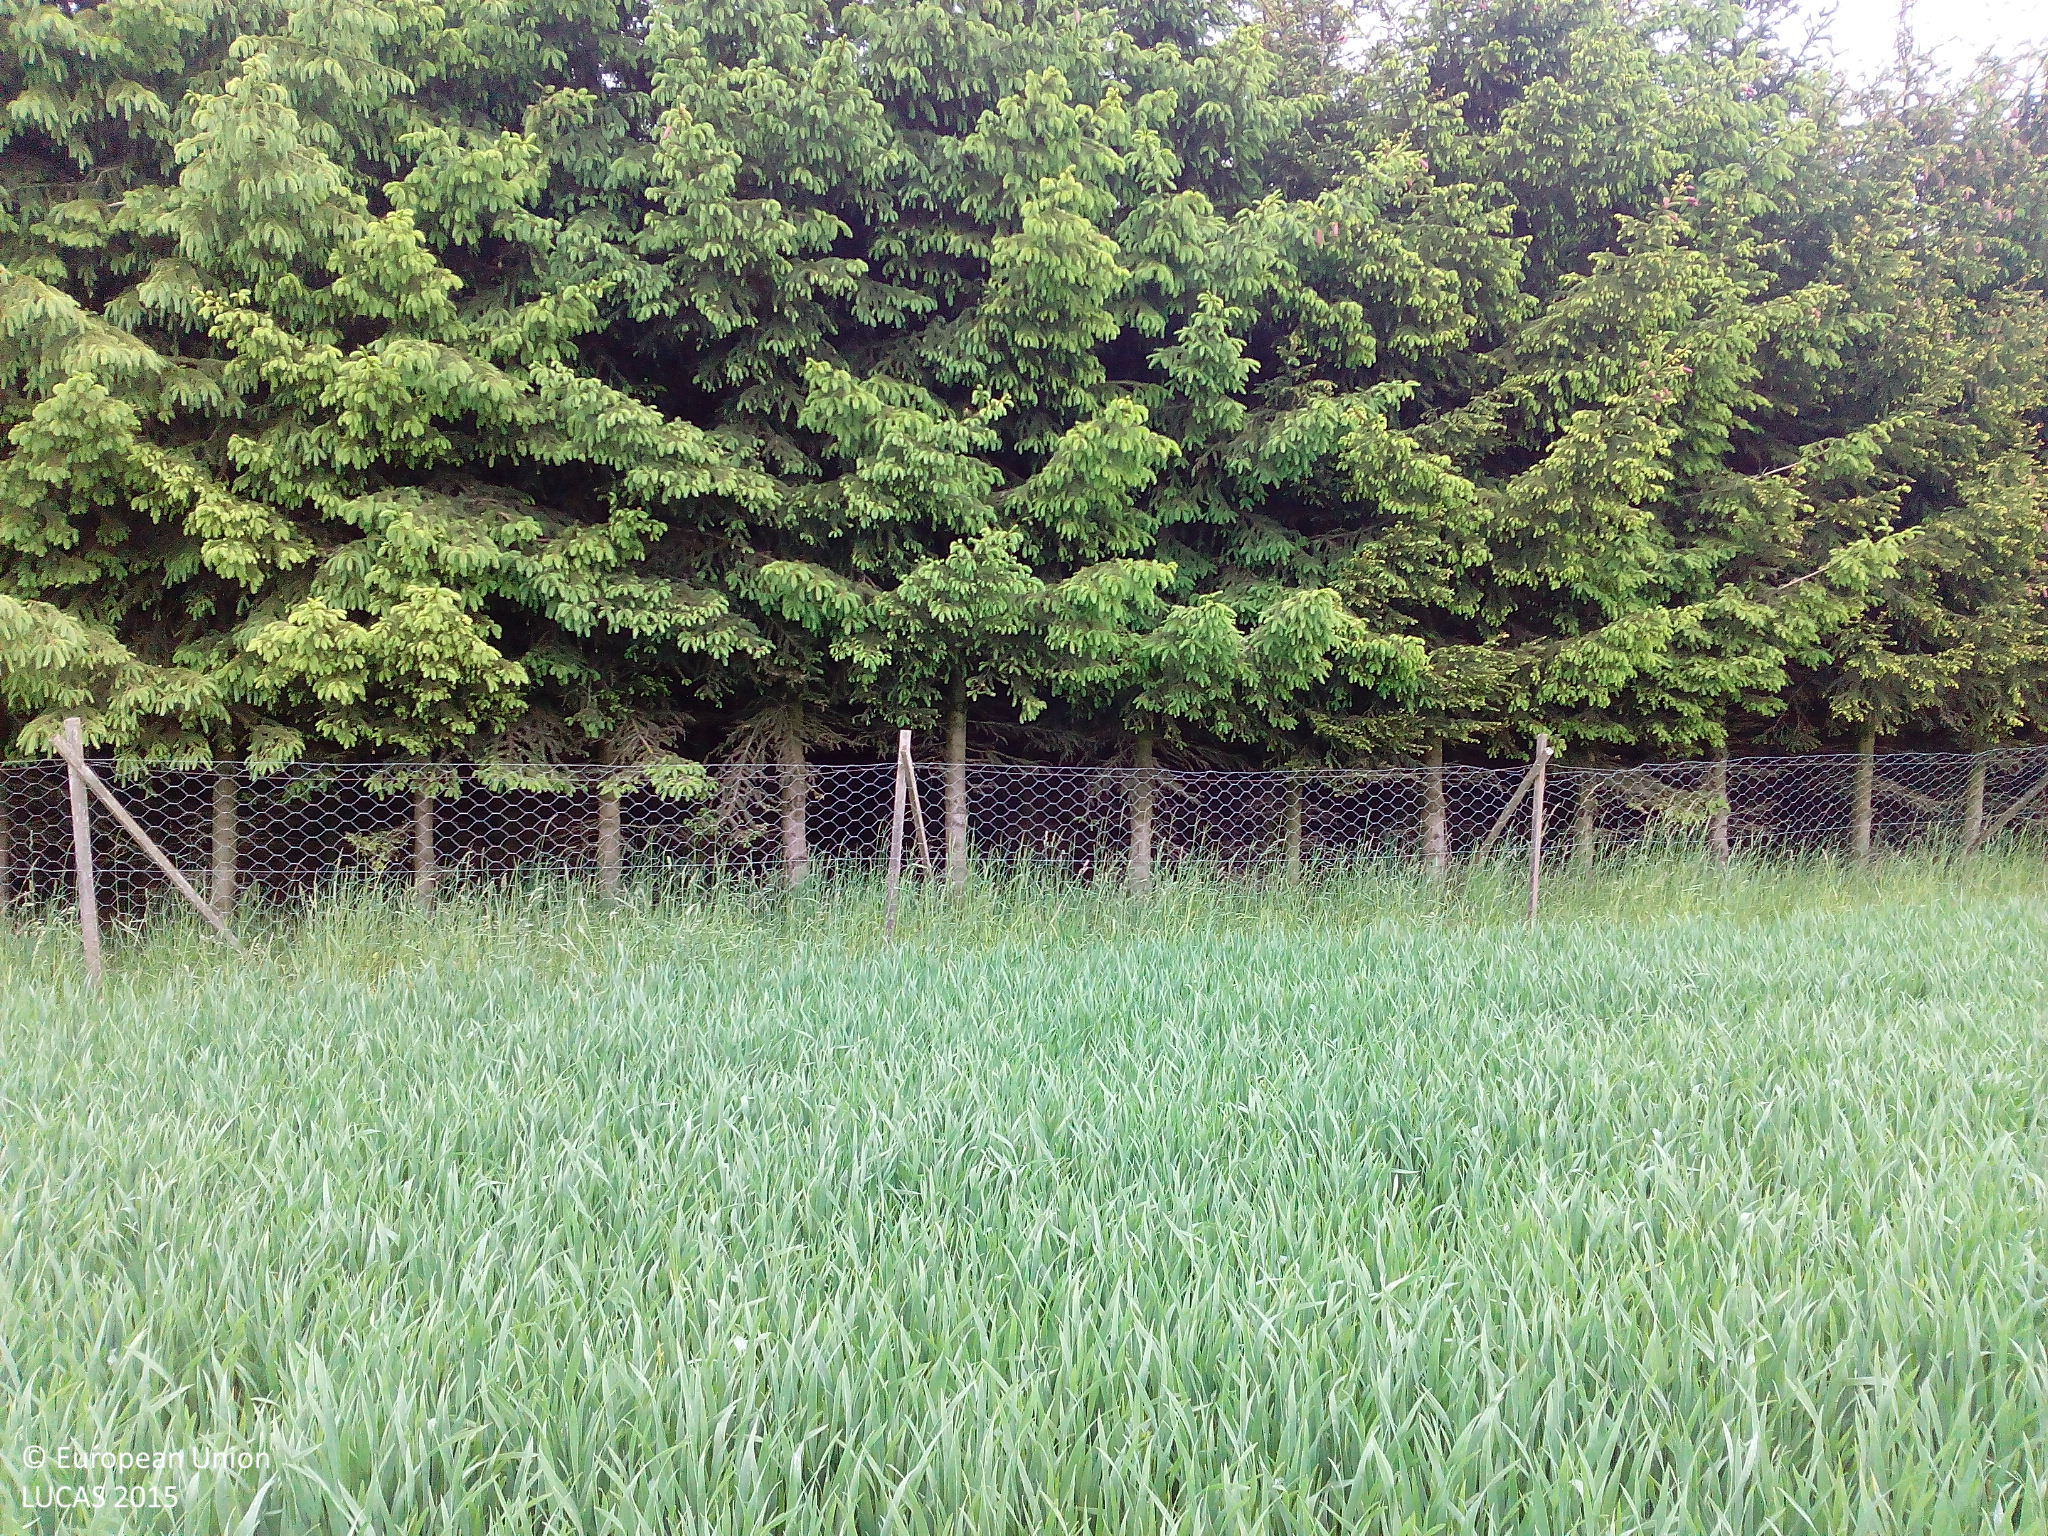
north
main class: Cropland
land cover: Common wheat
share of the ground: > 75 %
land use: Agriculture (excluding fallow land and kitchen gardens)
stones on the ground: < 10 %
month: May
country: DE
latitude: 49.2739
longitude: 11.5801
